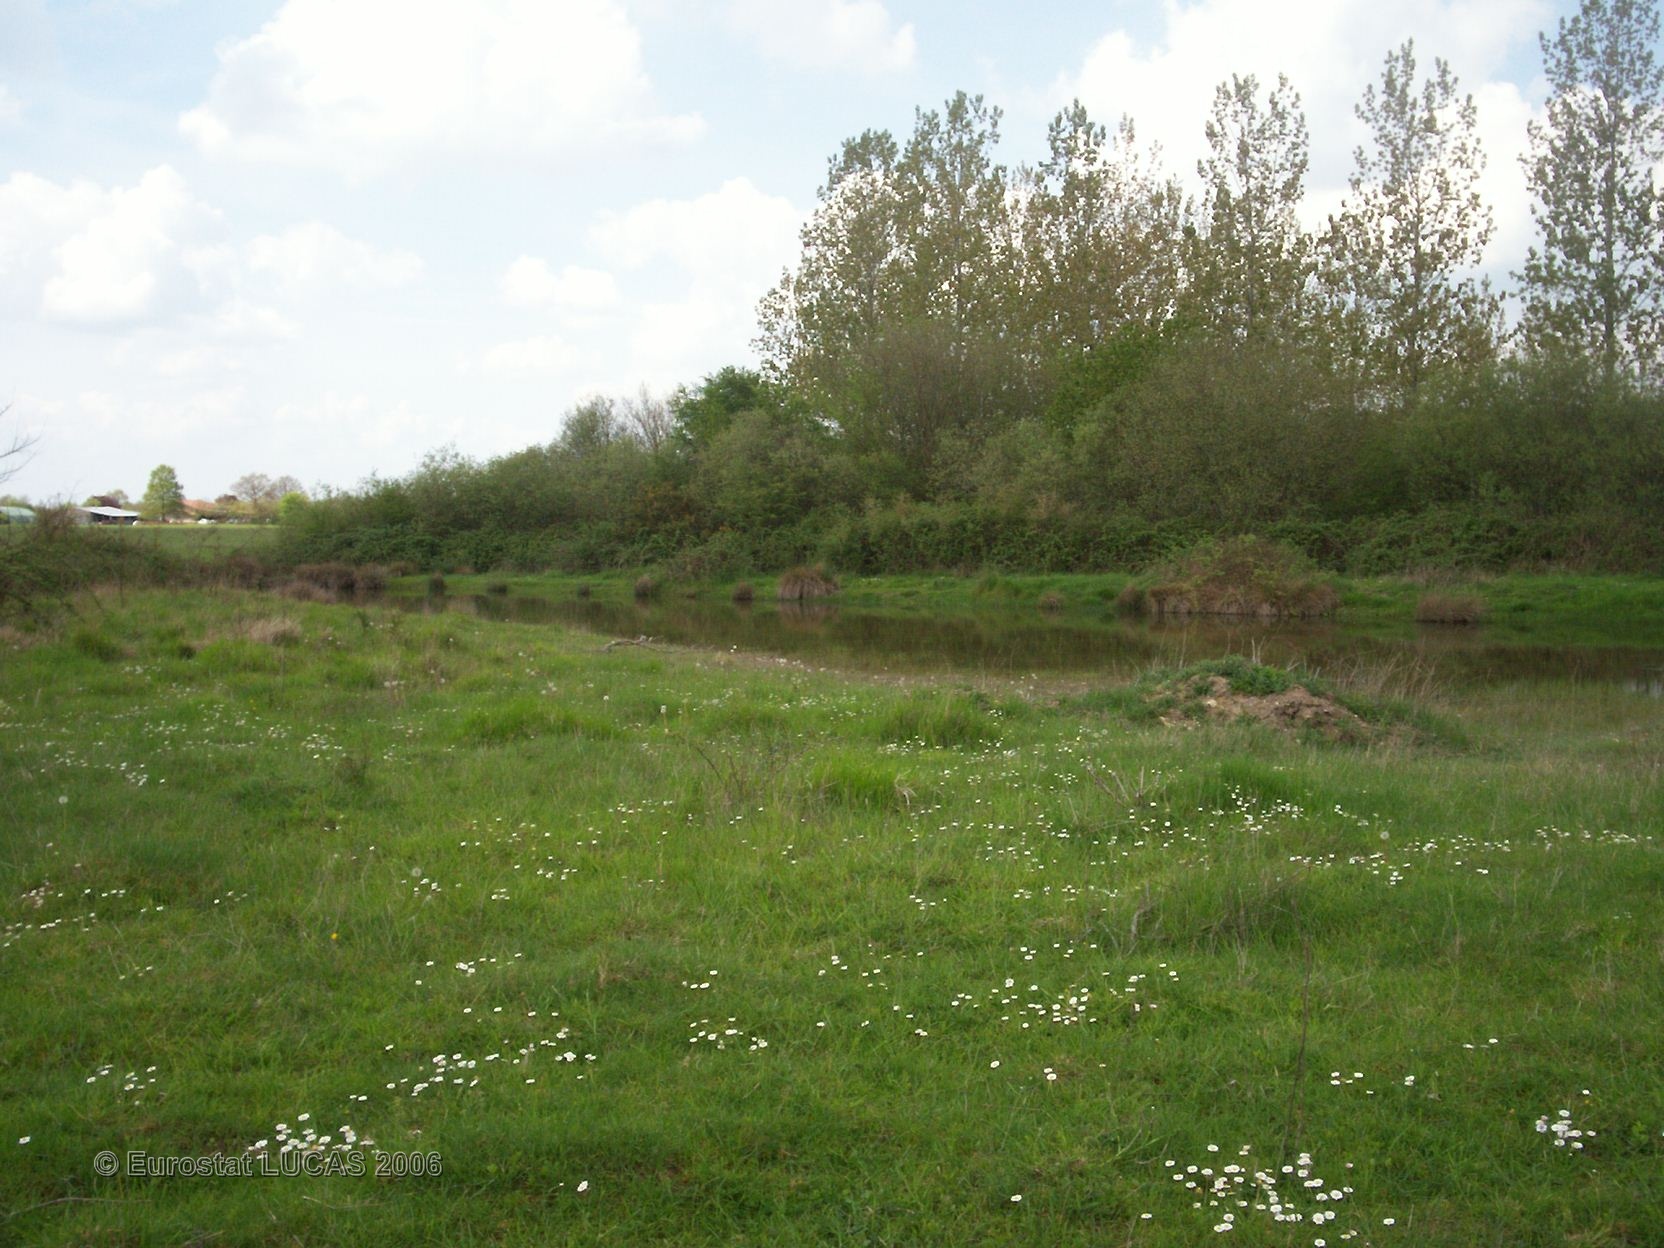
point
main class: Grassland
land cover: Grassland with sparse tree/shrub cover
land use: Agriculture (excluding fallow land and kitchen gardens)
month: April
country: FR
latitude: 46.3633
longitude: 0.5079
